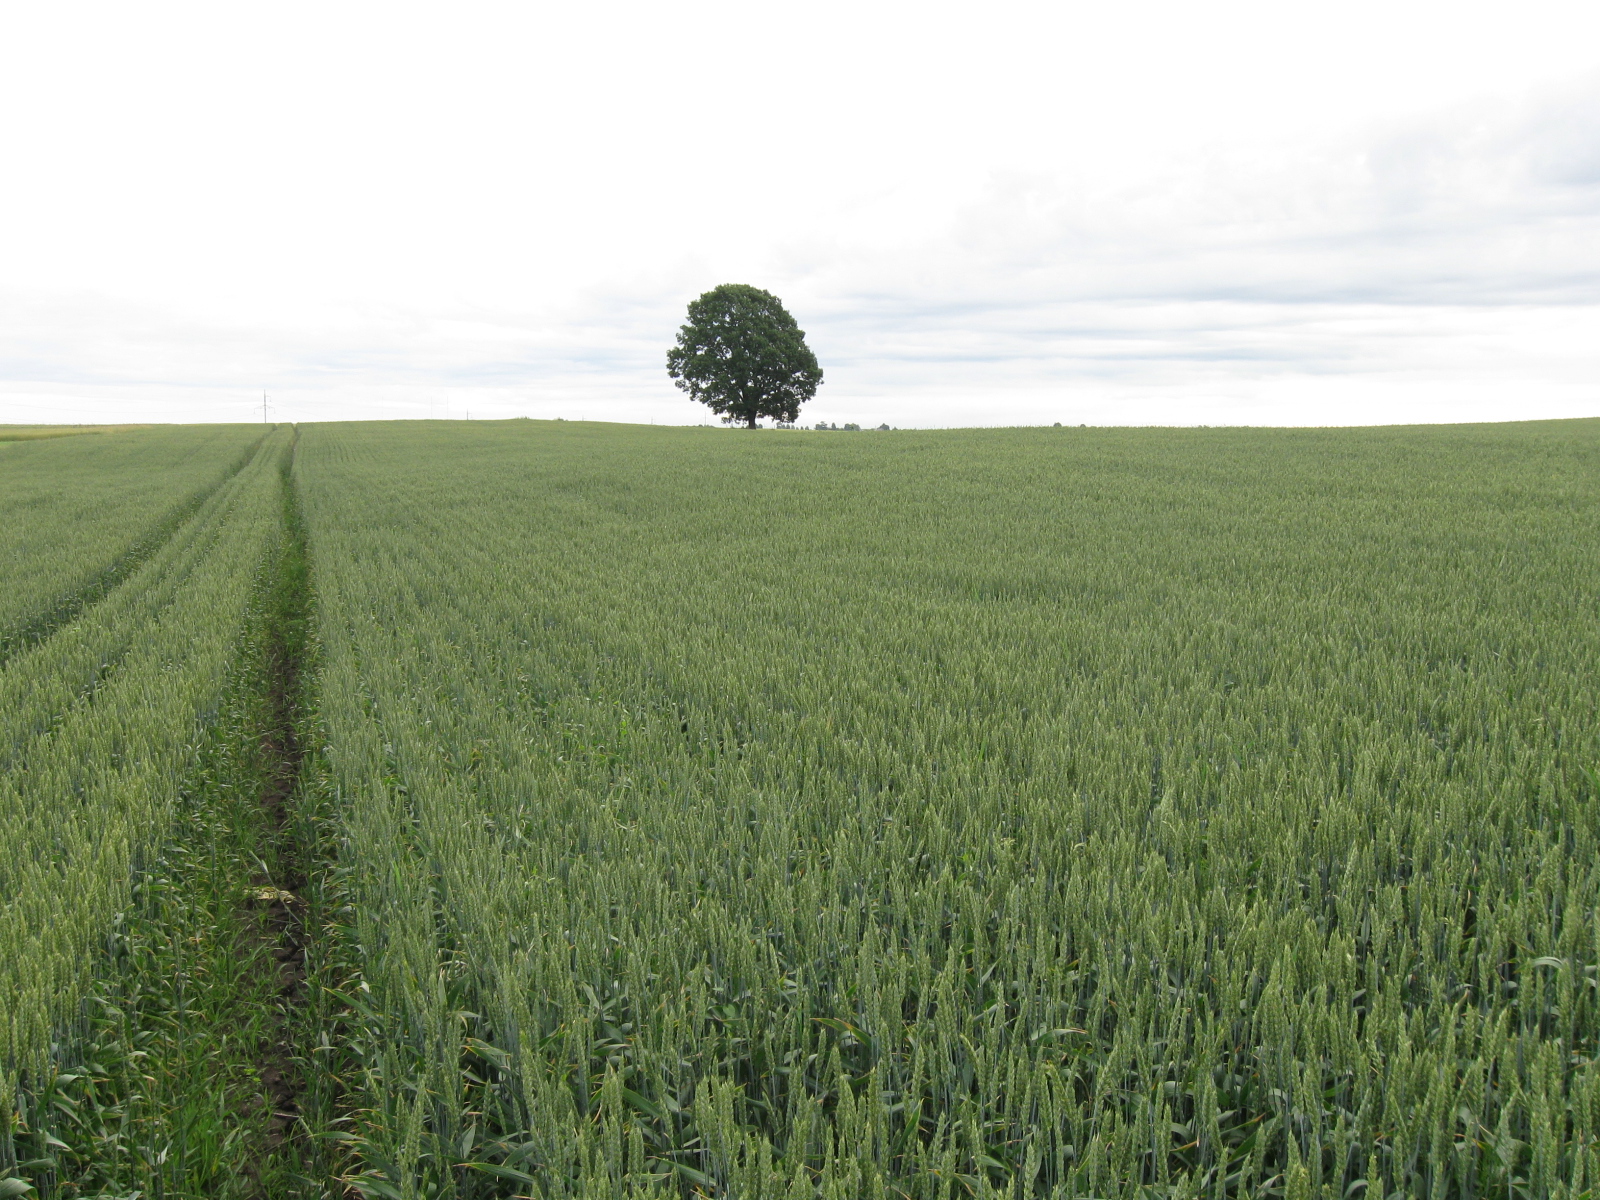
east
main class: Cropland
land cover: Common wheat
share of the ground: > 75 %
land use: Agriculture (excluding fallow land and kitchen gardens)
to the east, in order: Common wheat; Single bushes/trees; Common wheat; Spontaneously vegetated surfaces
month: July
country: LT
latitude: 55.0338
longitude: 23.6487
